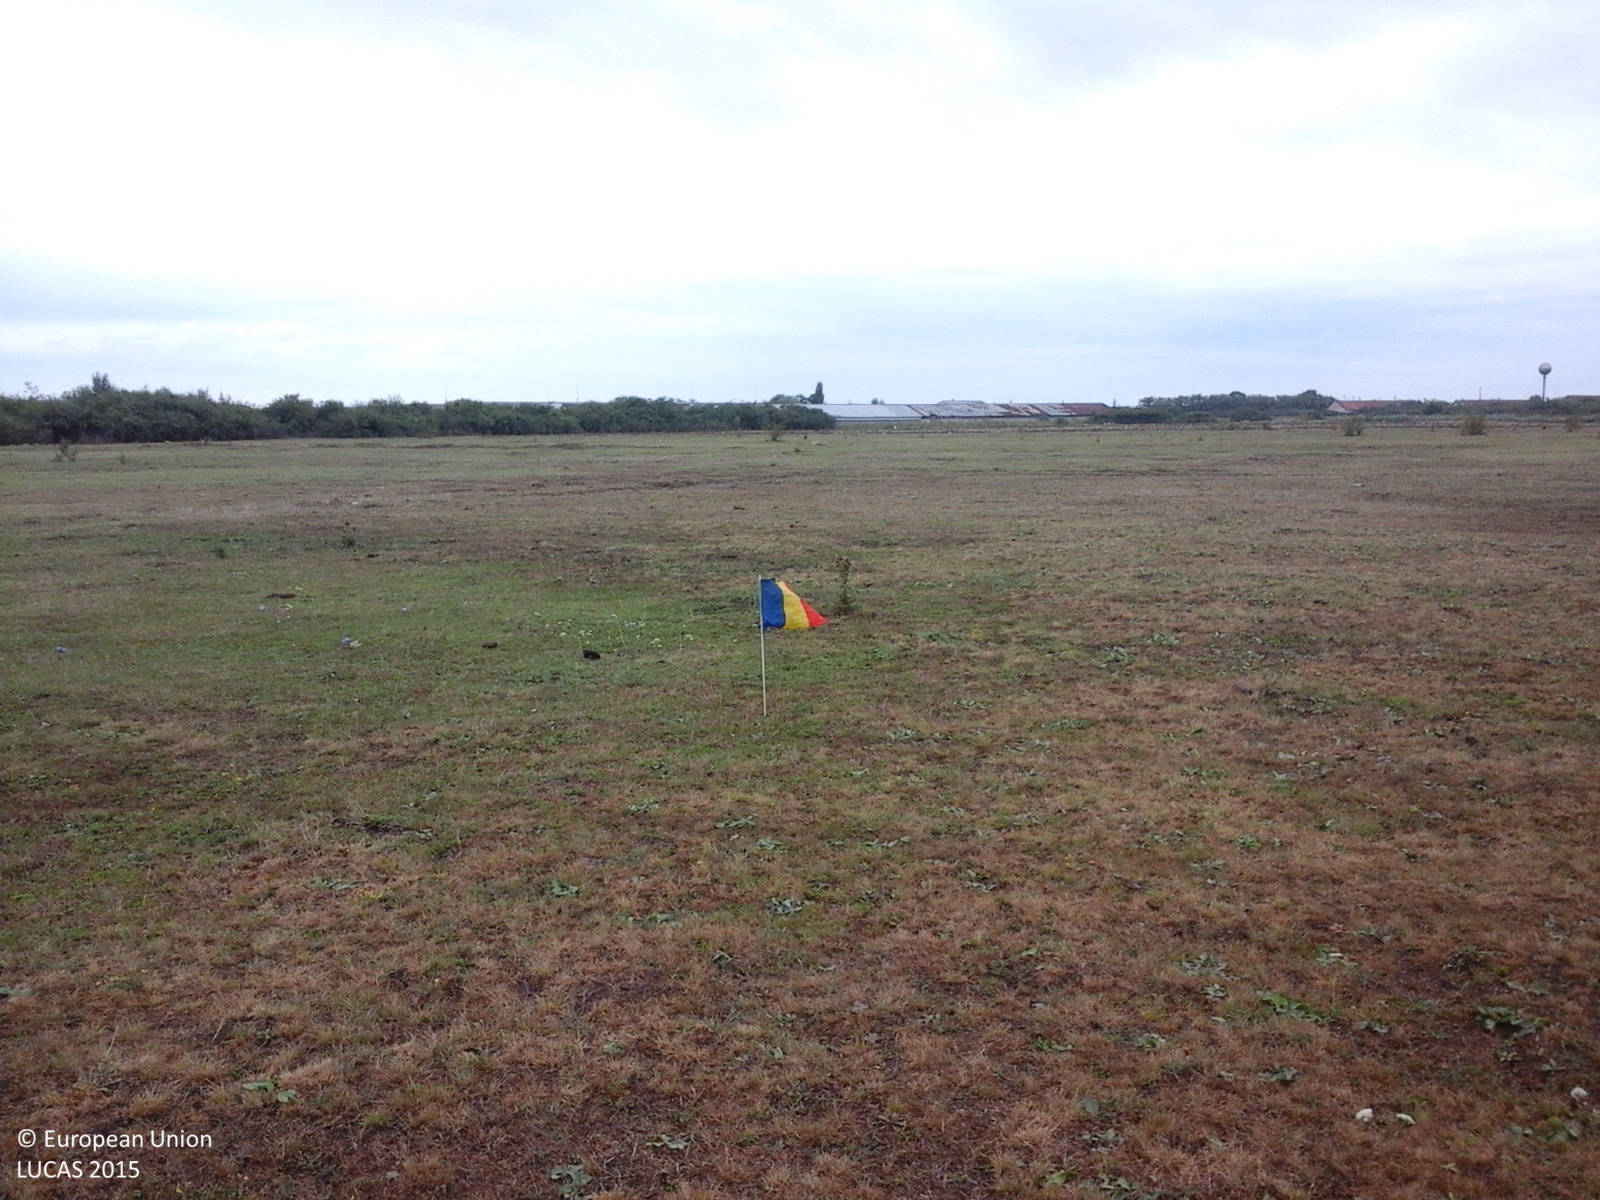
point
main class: Grassland
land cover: Grassland without tree/shrub cover
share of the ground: > 75 %
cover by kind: herbaceous plants 100 %
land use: Agriculture (excluding fallow land and kitchen gardens)
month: August
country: RO
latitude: 45.5455
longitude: 21.0033
